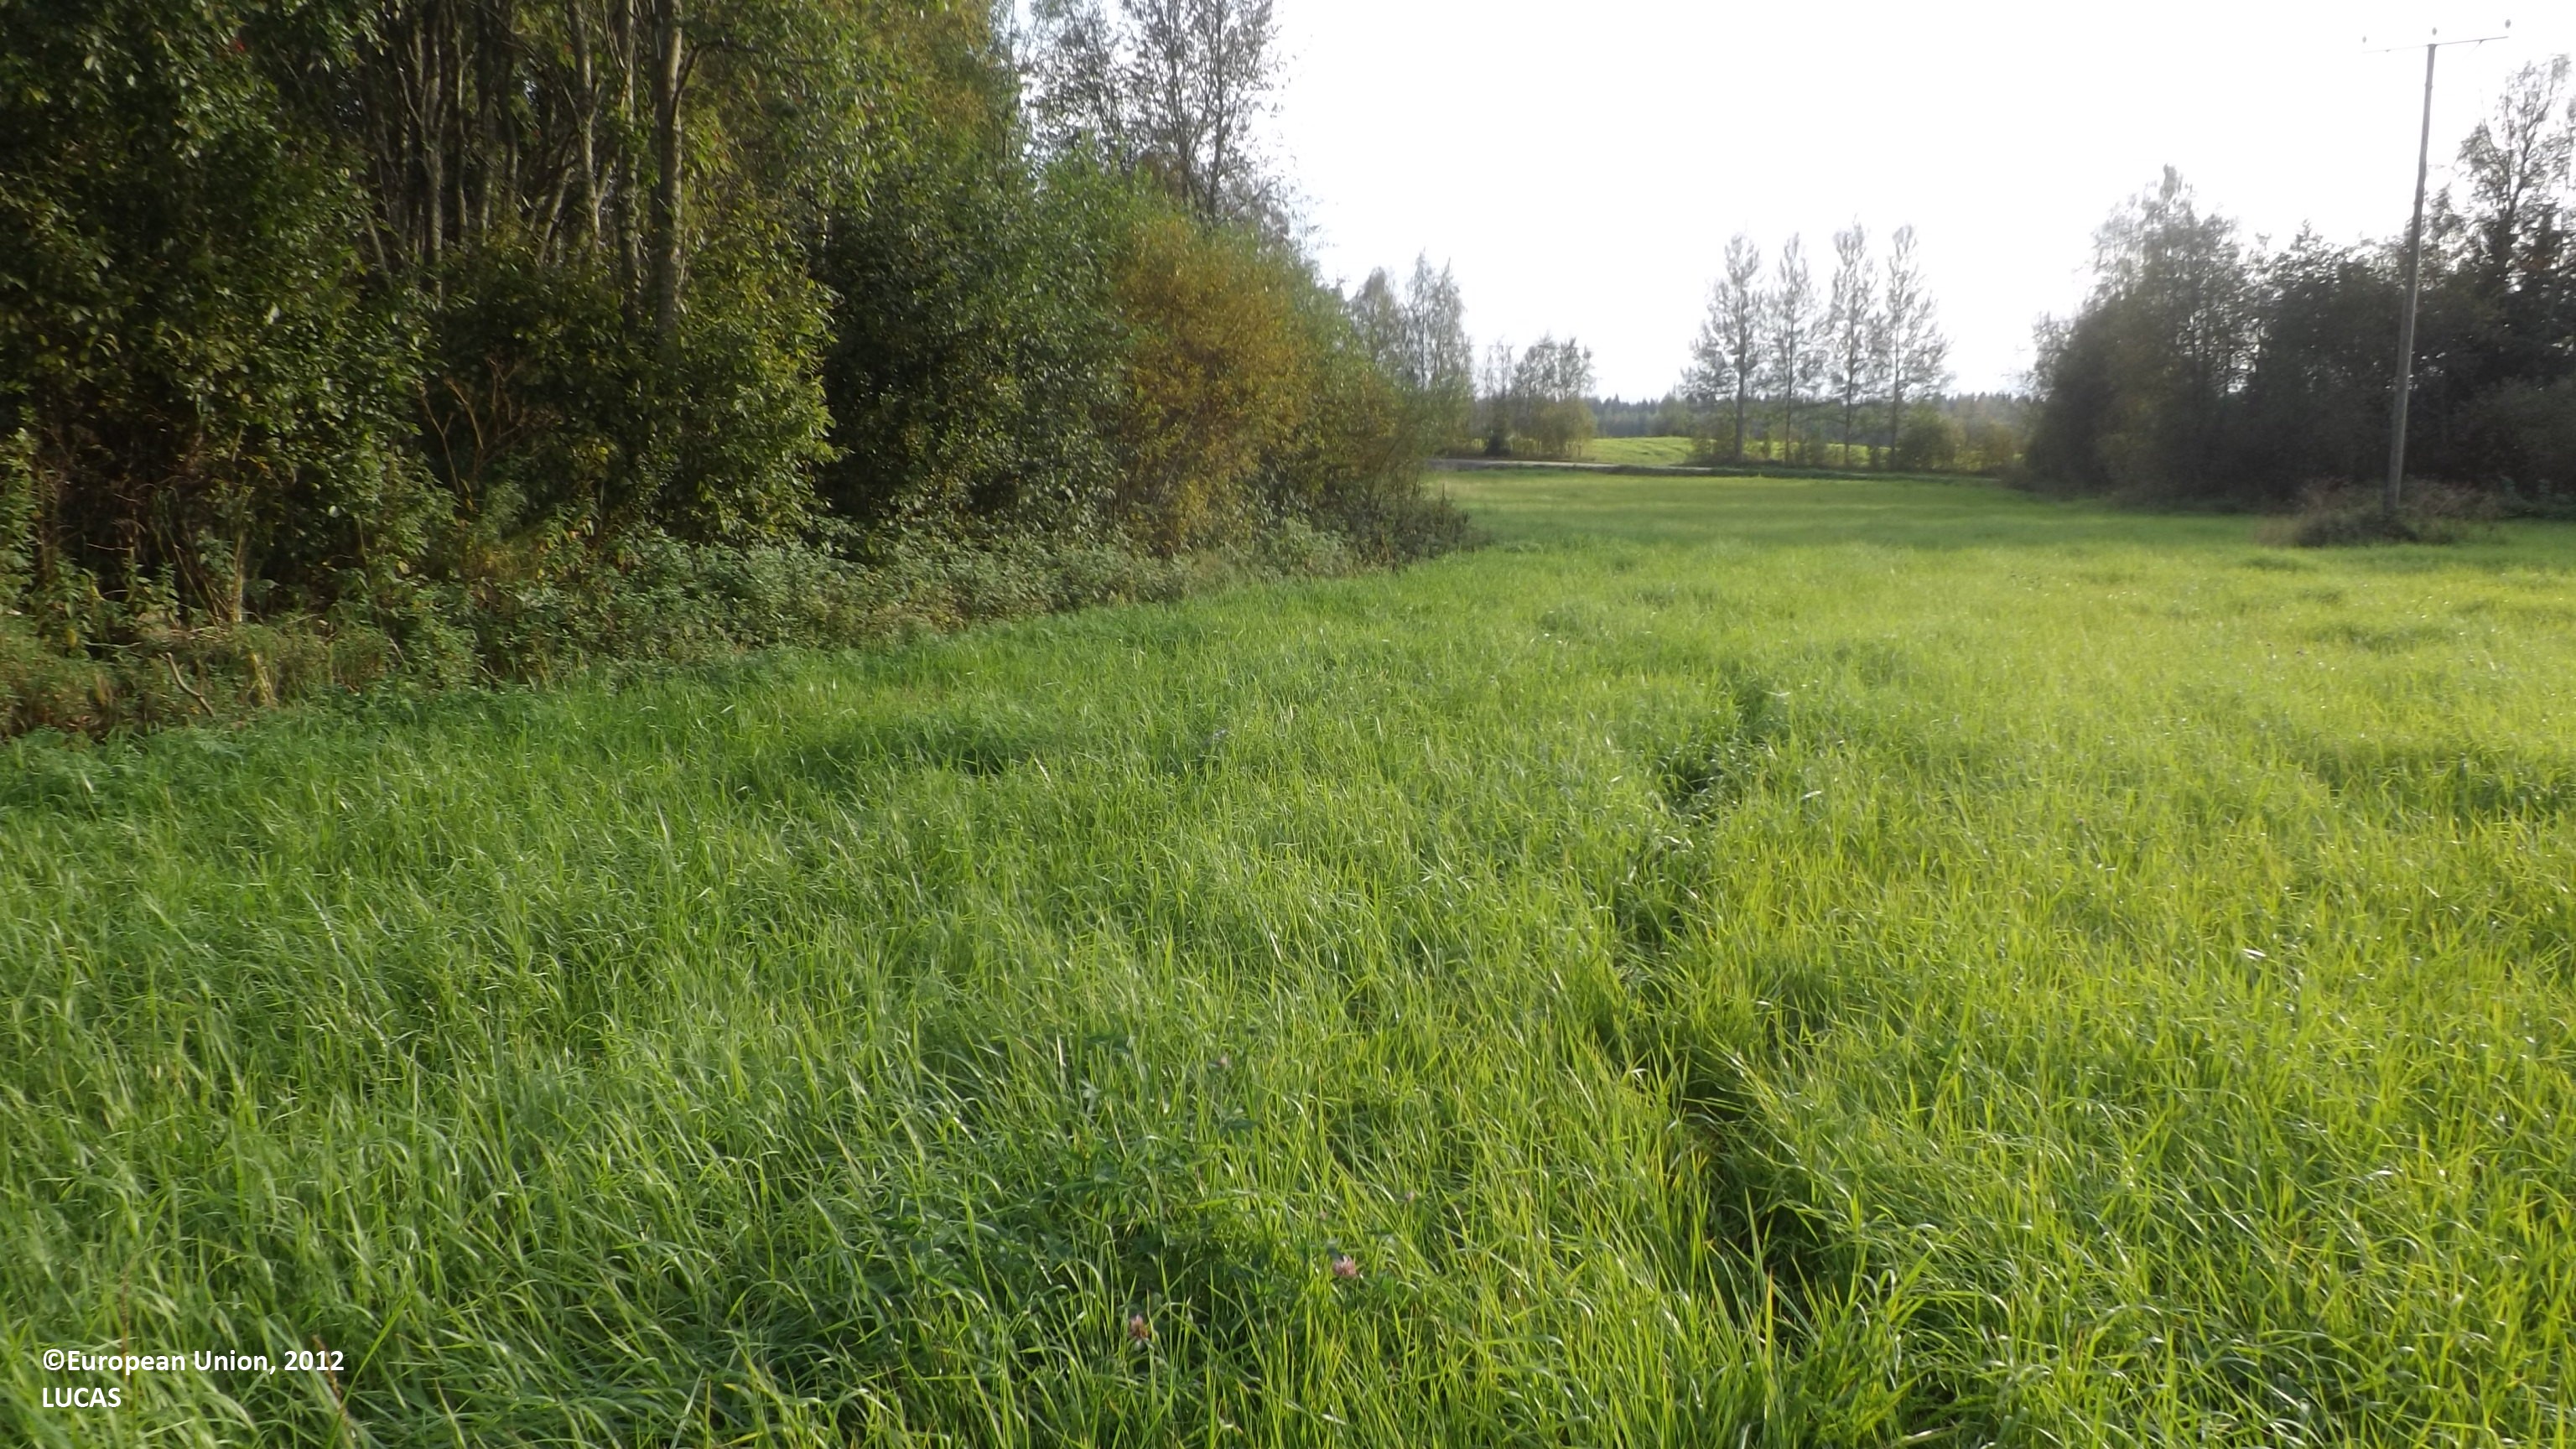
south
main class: Cropland
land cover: Temporary grasslands
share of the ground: > 75 %
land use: Agriculture (excluding fallow land and kitchen gardens)
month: August
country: FI
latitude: 63.8119
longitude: 23.3594
